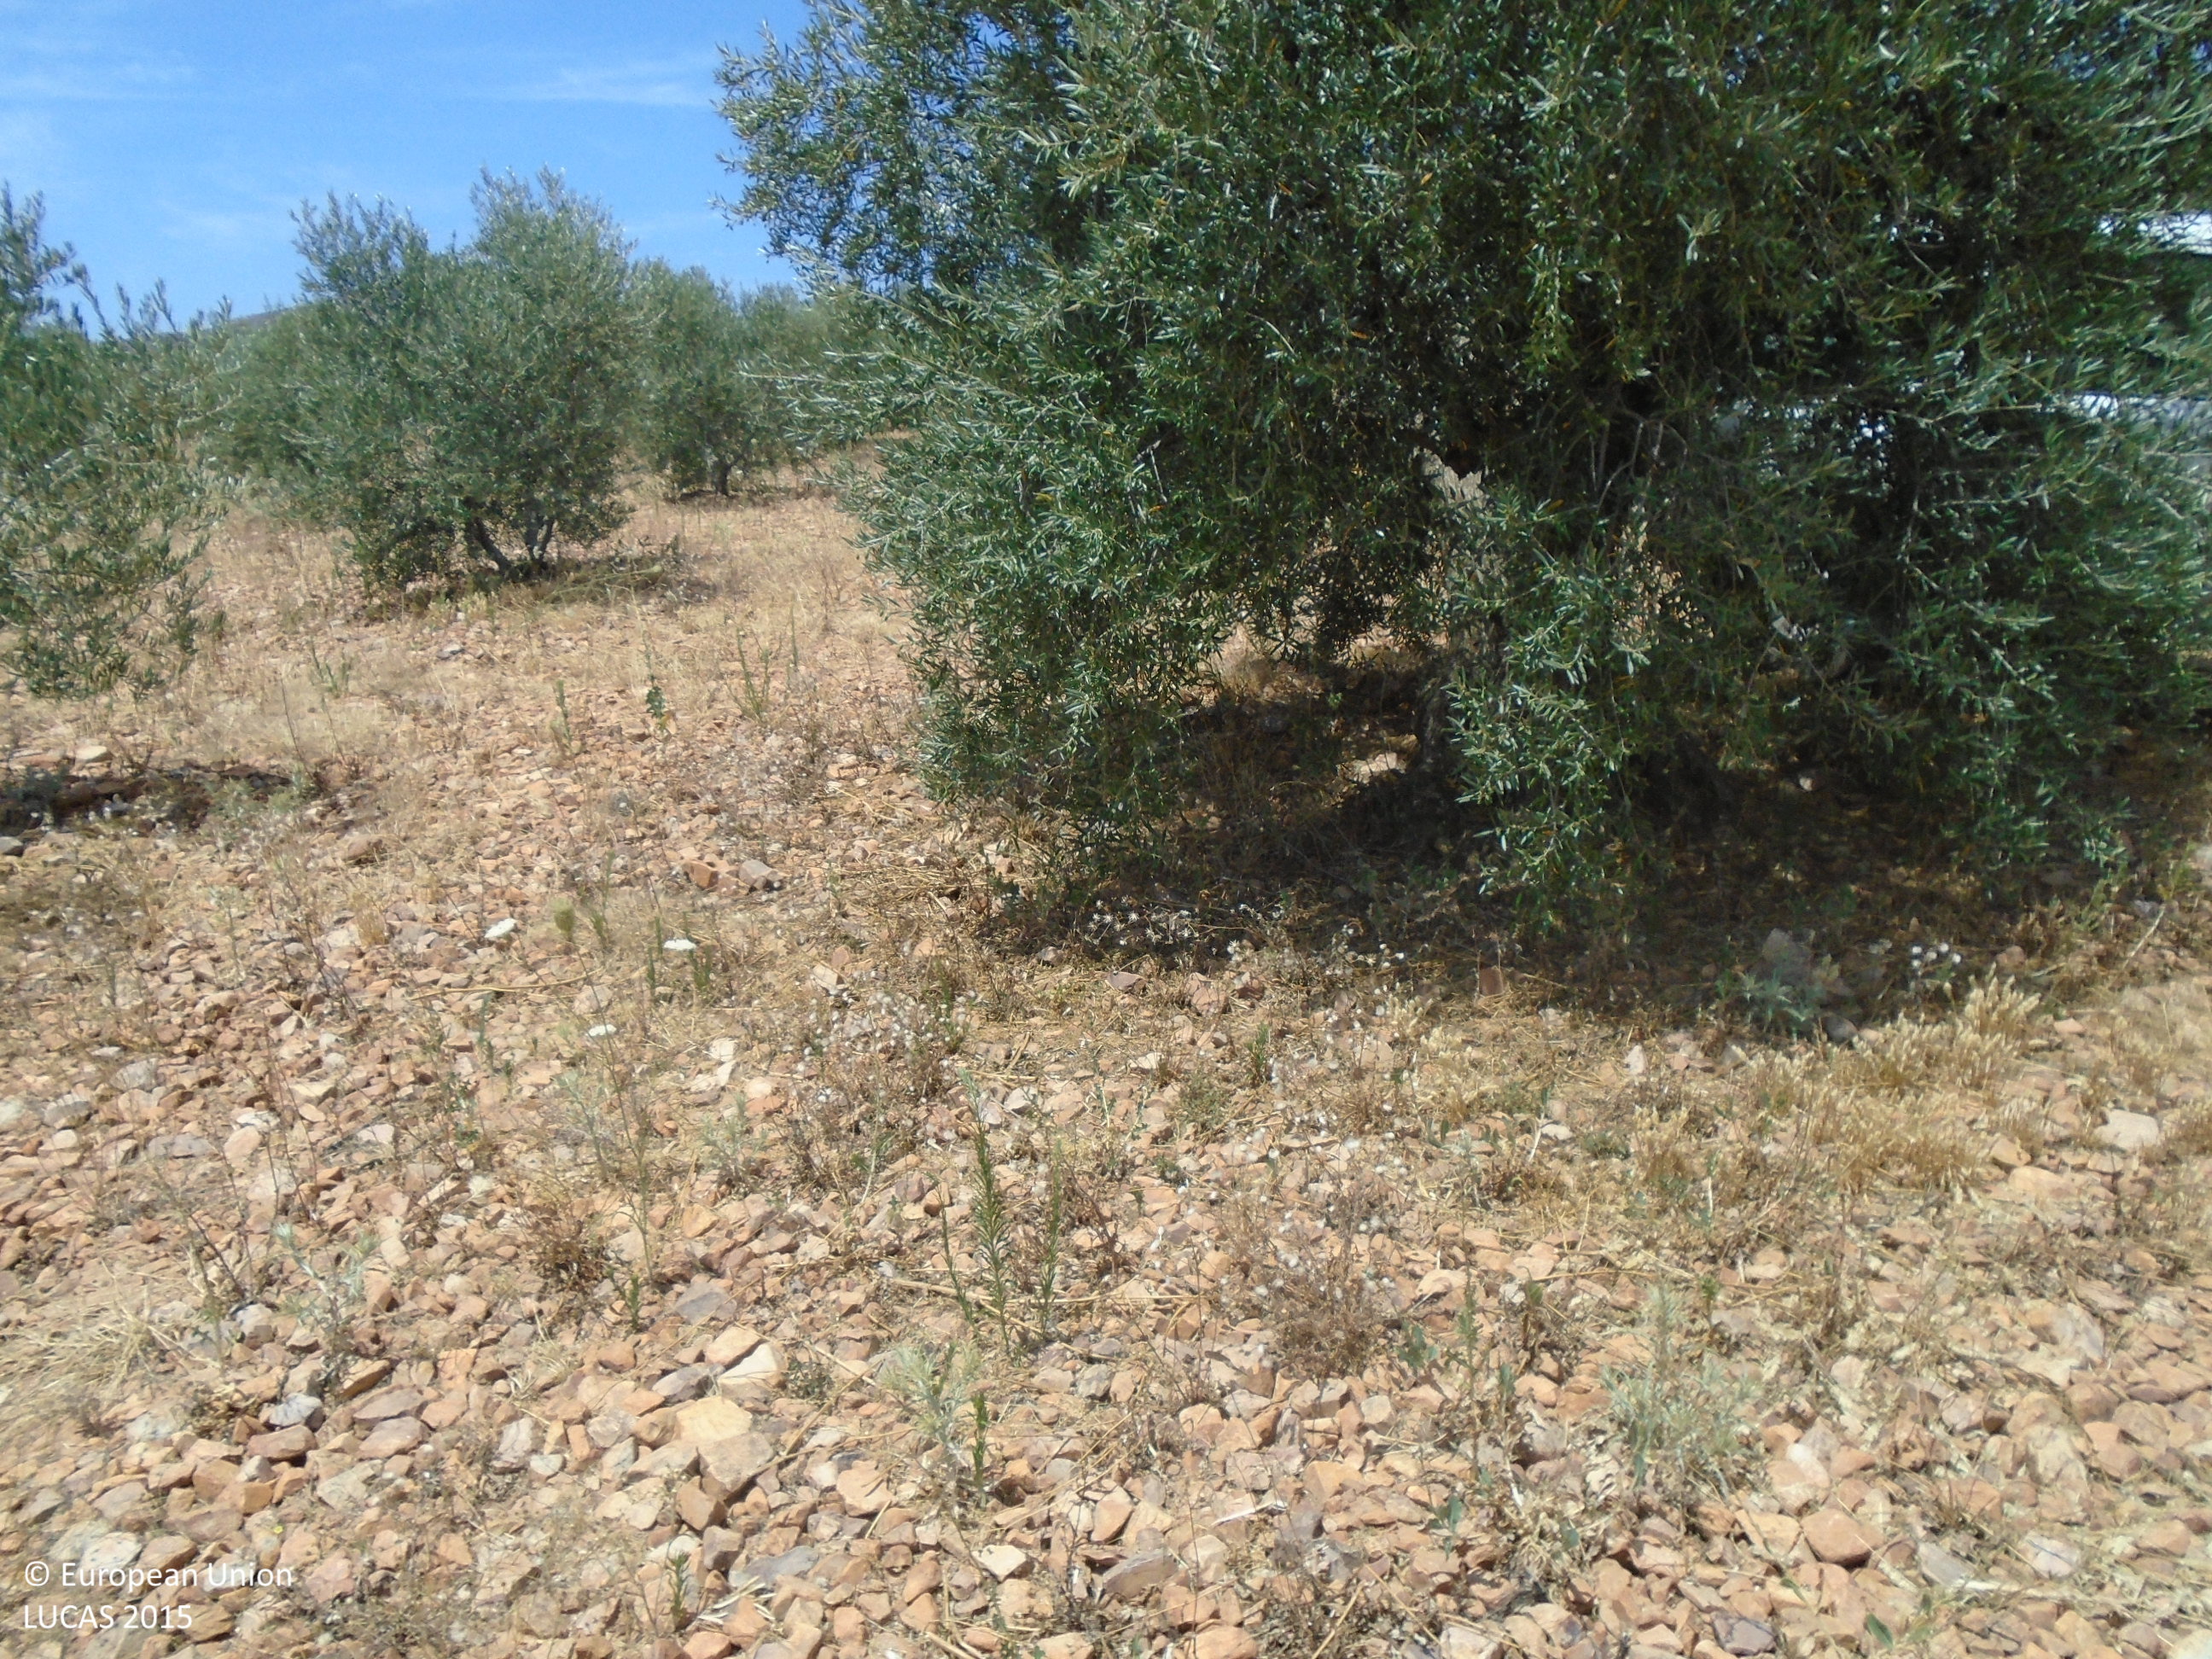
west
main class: Cropland
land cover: Olive groves
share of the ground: 10 - 25 %
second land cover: Other bare soil
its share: > 75 %
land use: Agriculture (excluding fallow land and kitchen gardens)
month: June
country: ES
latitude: 39.2406
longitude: -3.6108
